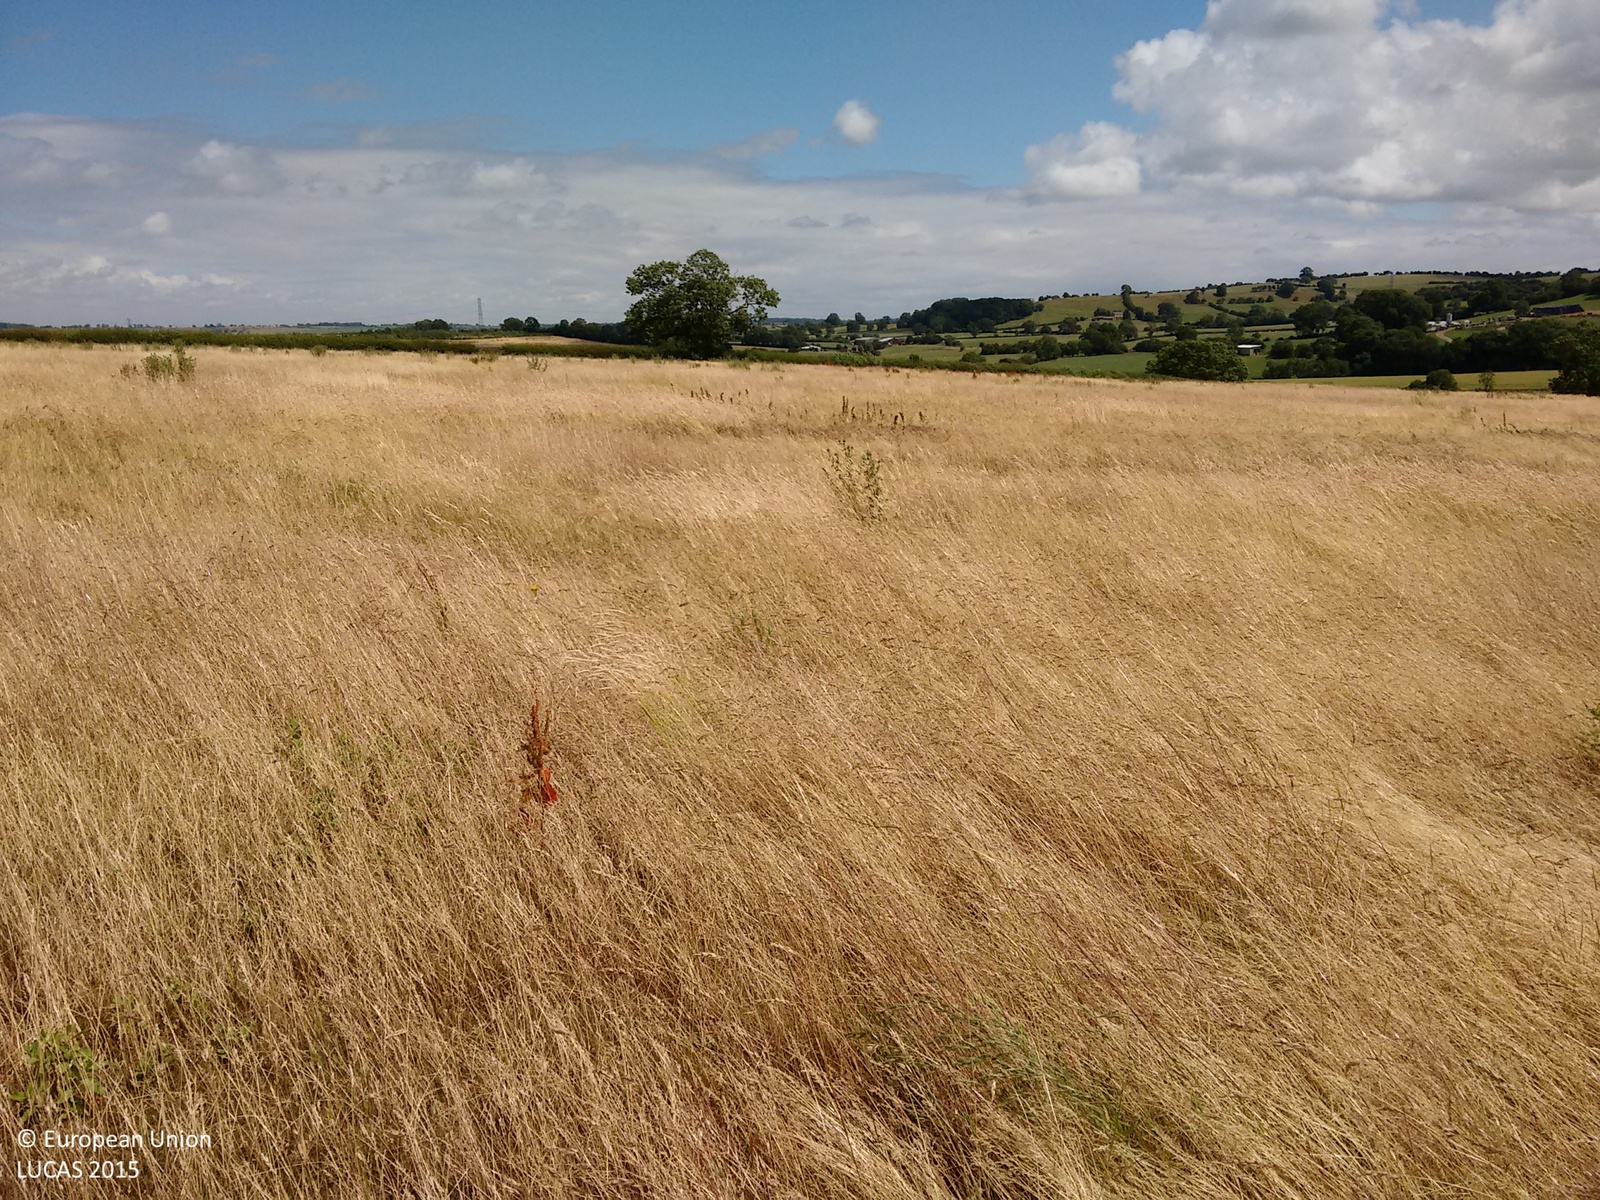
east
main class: Grassland
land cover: Grassland without tree/shrub cover
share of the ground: > 75 %
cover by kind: herbaceous plants 100 %
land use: Agriculture (excluding fallow land and kitchen gardens)
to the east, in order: Grassland without tree/shrub cover; Managed hedges; Fences; Grassland without tree/shrub cover; Fences; Managed hedges; Grassland without tree/shrub cover
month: July
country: GB
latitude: 52.6508
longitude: -0.9373
